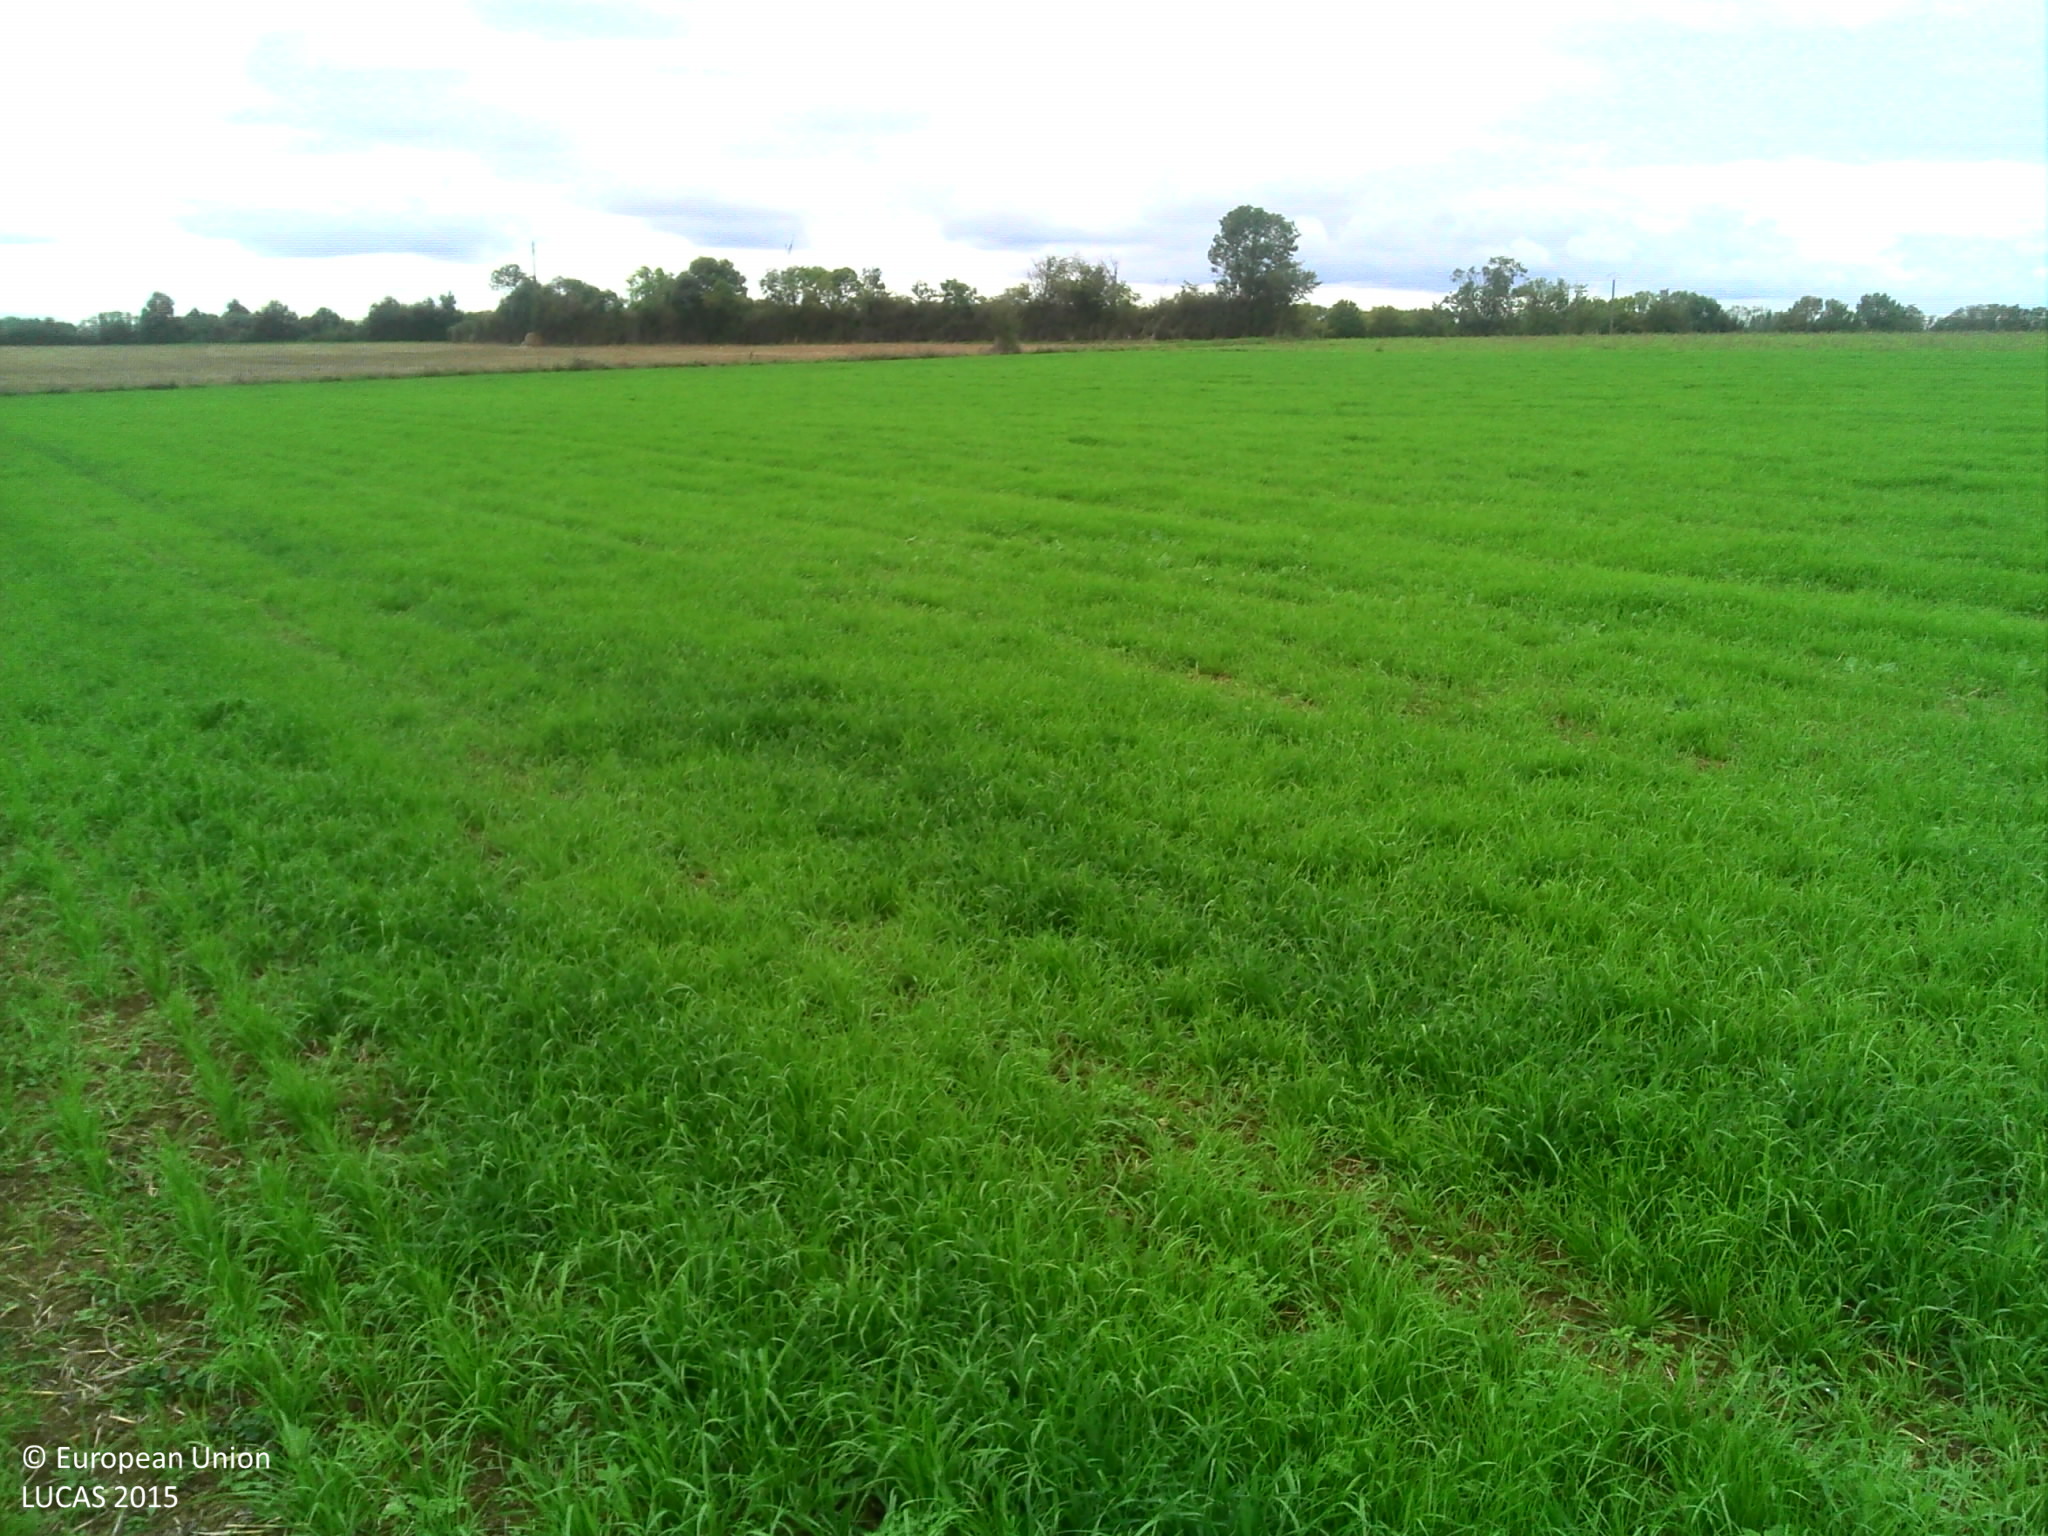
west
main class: Cropland
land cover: Temporary grasslands
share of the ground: > 75 %
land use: Agriculture (excluding fallow land and kitchen gardens)
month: September
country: FR
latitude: 46.7204
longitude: -1.0628
